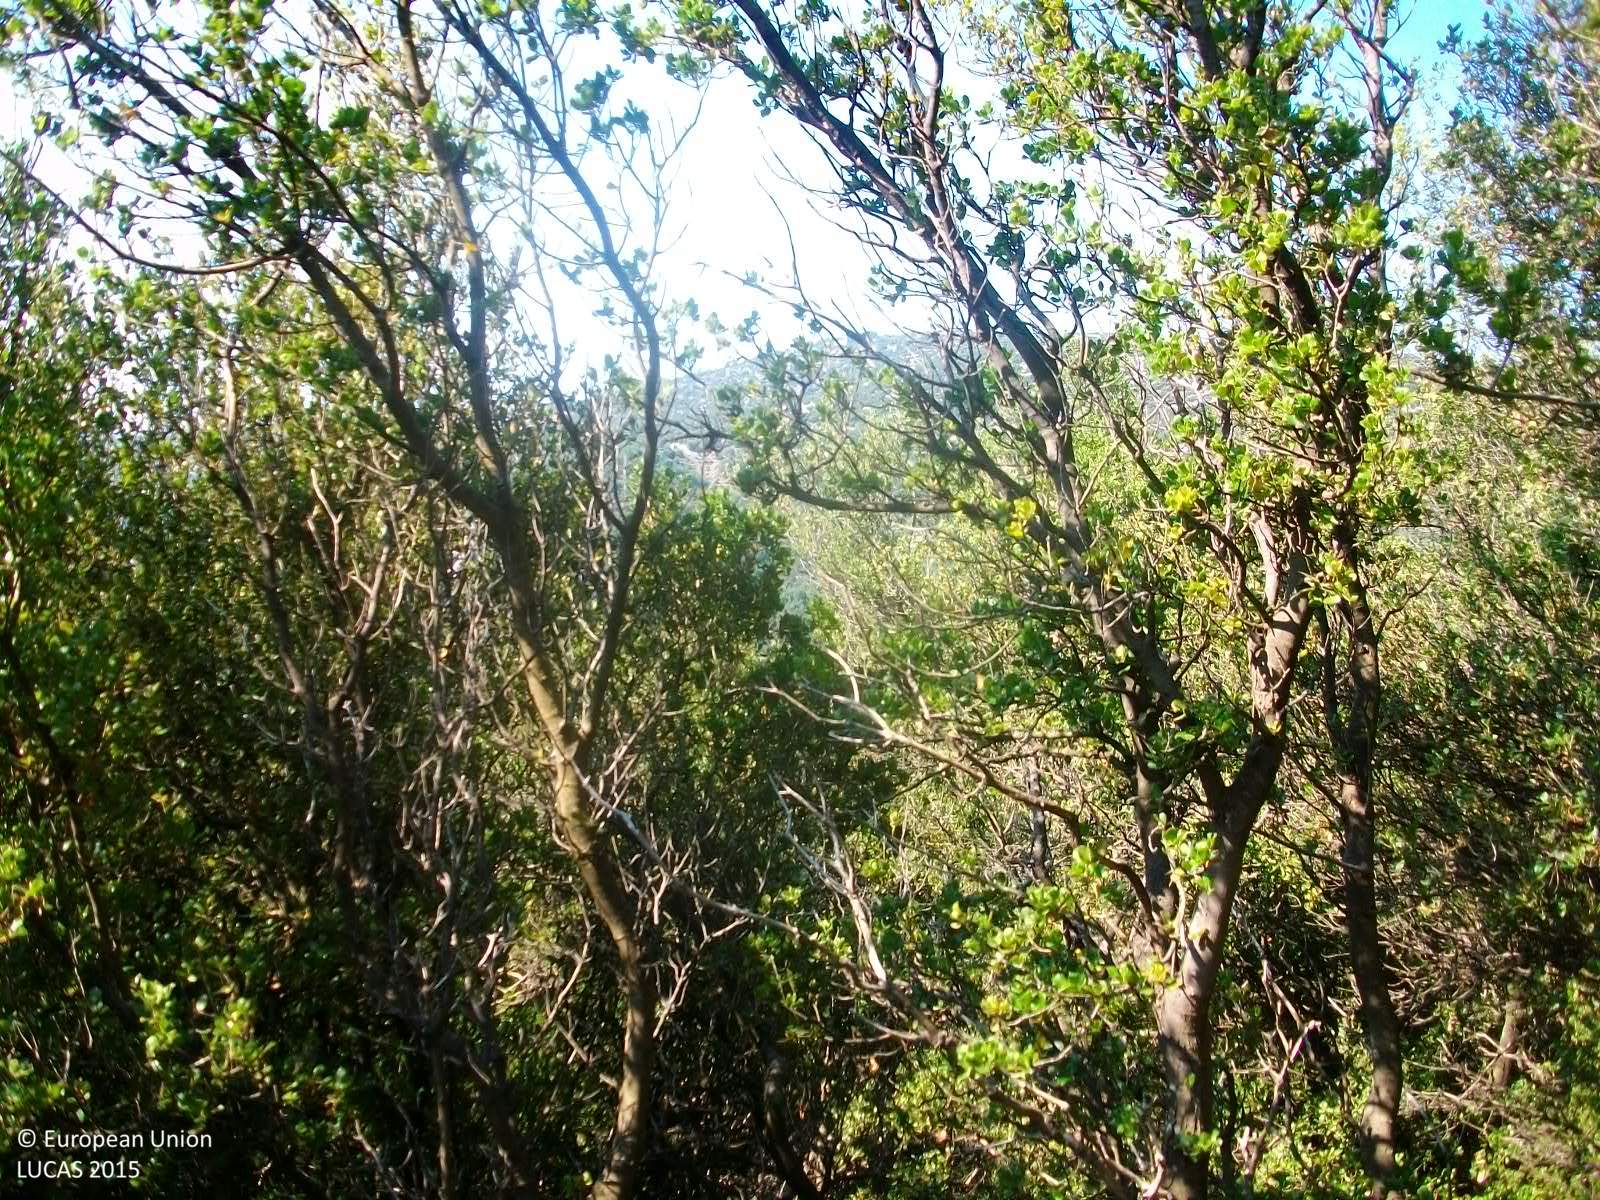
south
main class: Shrubland
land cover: Shrubland with sparse tree cover
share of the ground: > 75 %
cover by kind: shrubs 95 %, broadleaved forest trees 5 %
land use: Semi-natural and natural areas not in use
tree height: > 5 m
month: July
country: GR
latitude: 37.4308
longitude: 21.9486
